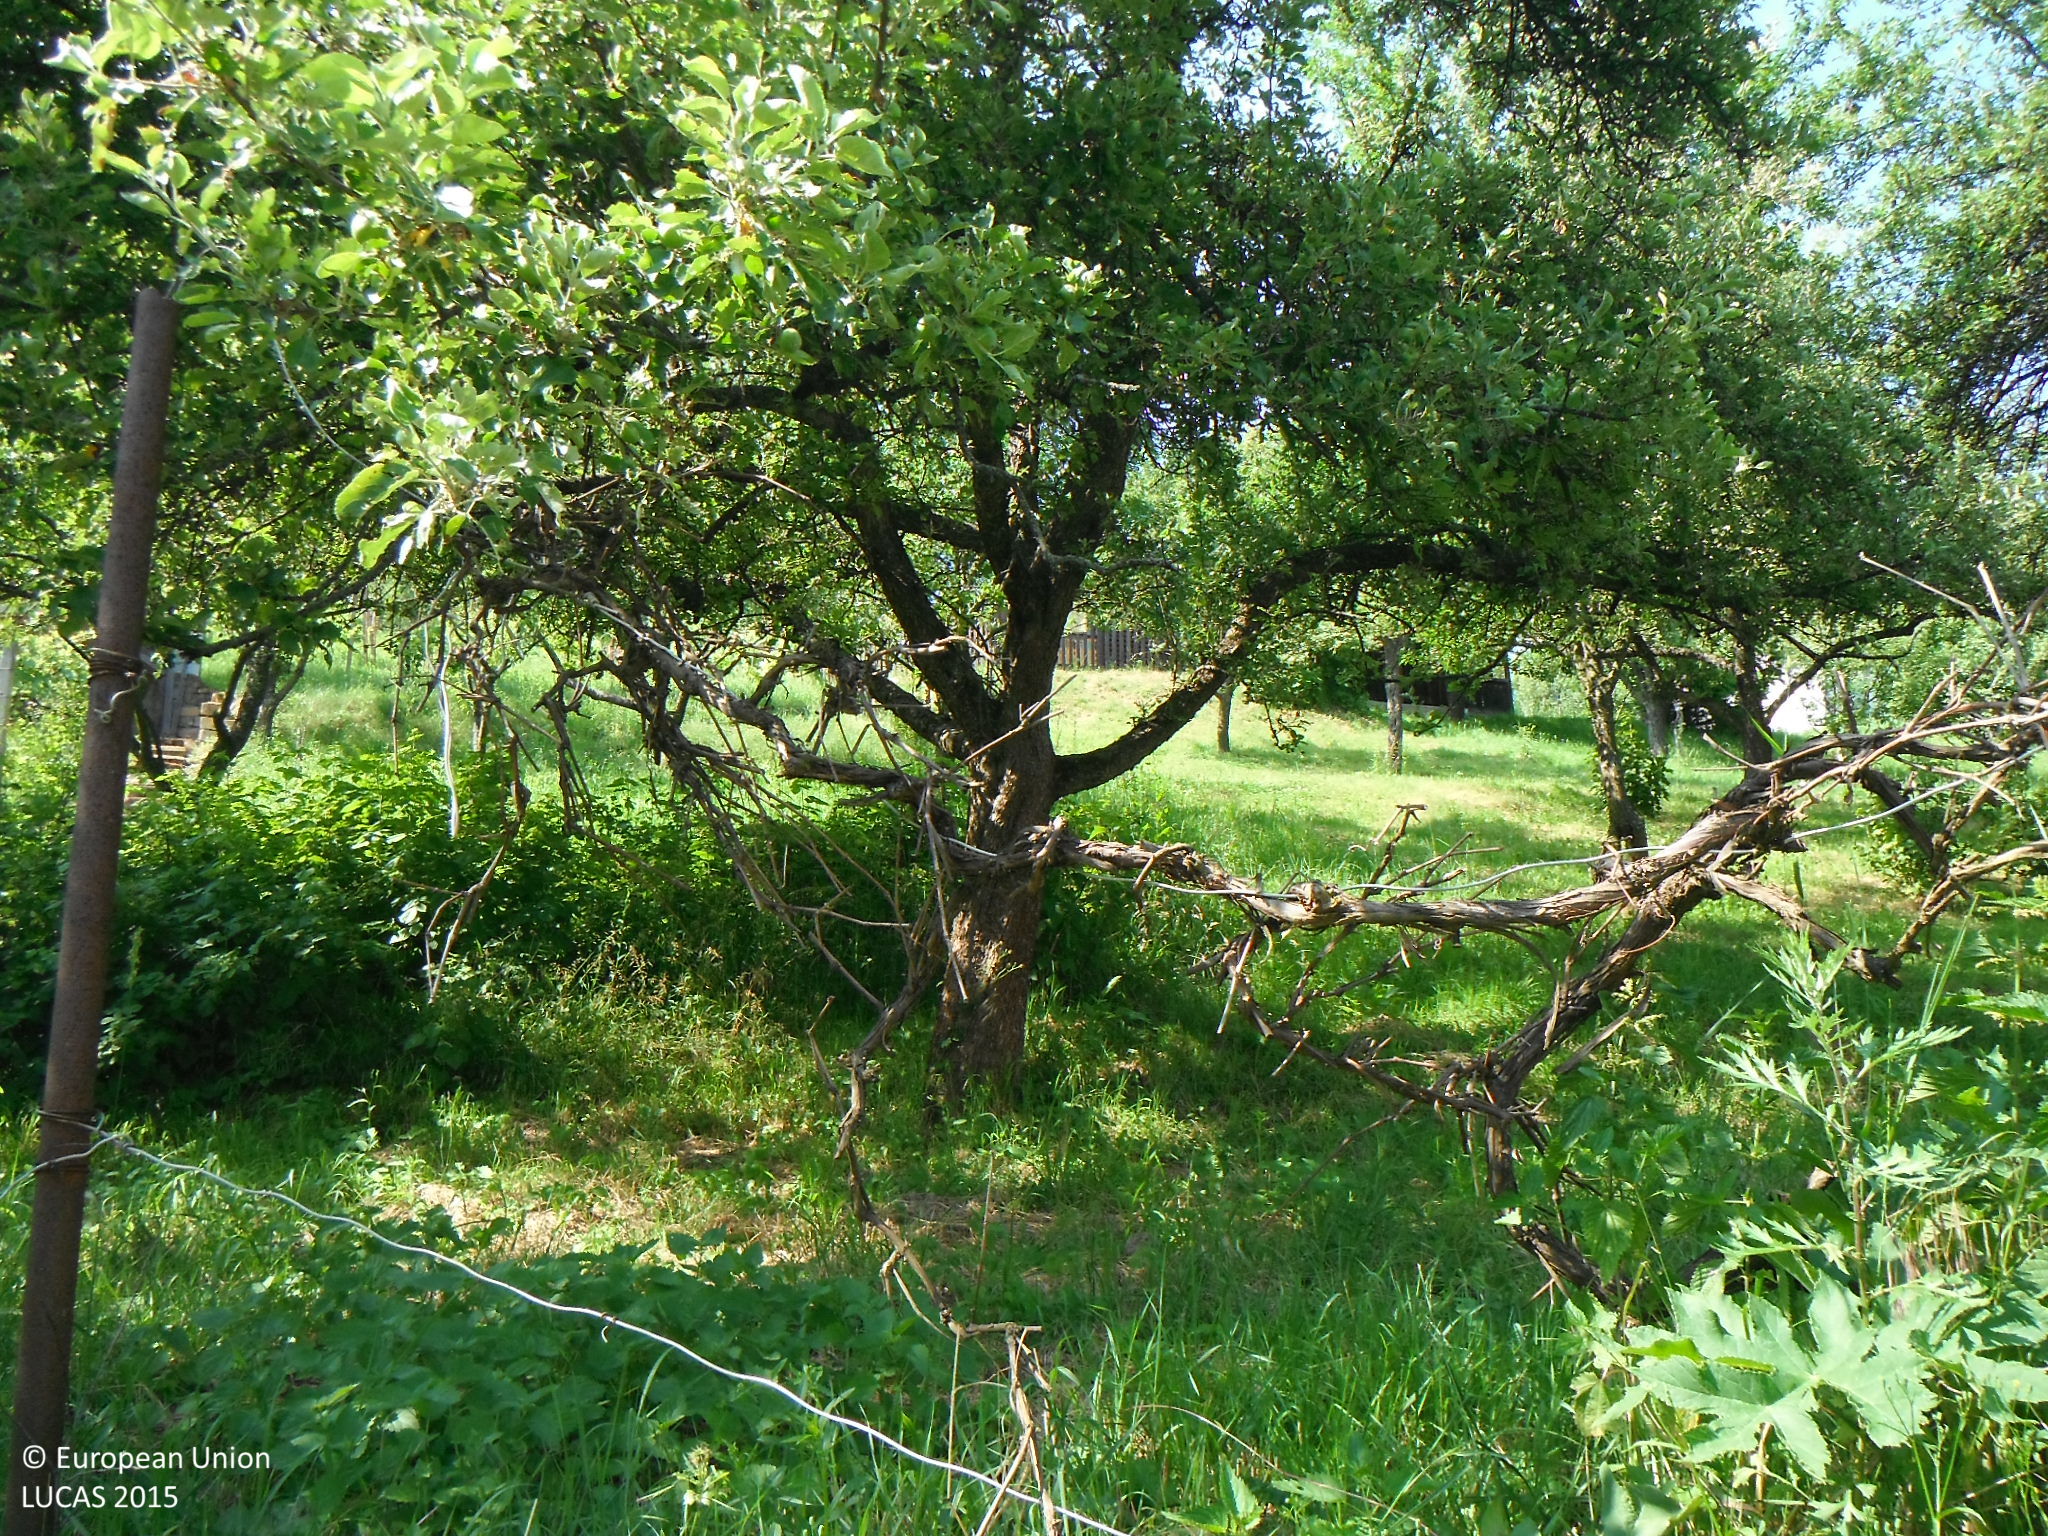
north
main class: Cropland
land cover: Apple fruit
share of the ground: 50 - 75 %
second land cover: Grassland without tree/shrub cover
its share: > 75 %
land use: Kitchen garden
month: June
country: SK
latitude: 48.4619
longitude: 19.5321
